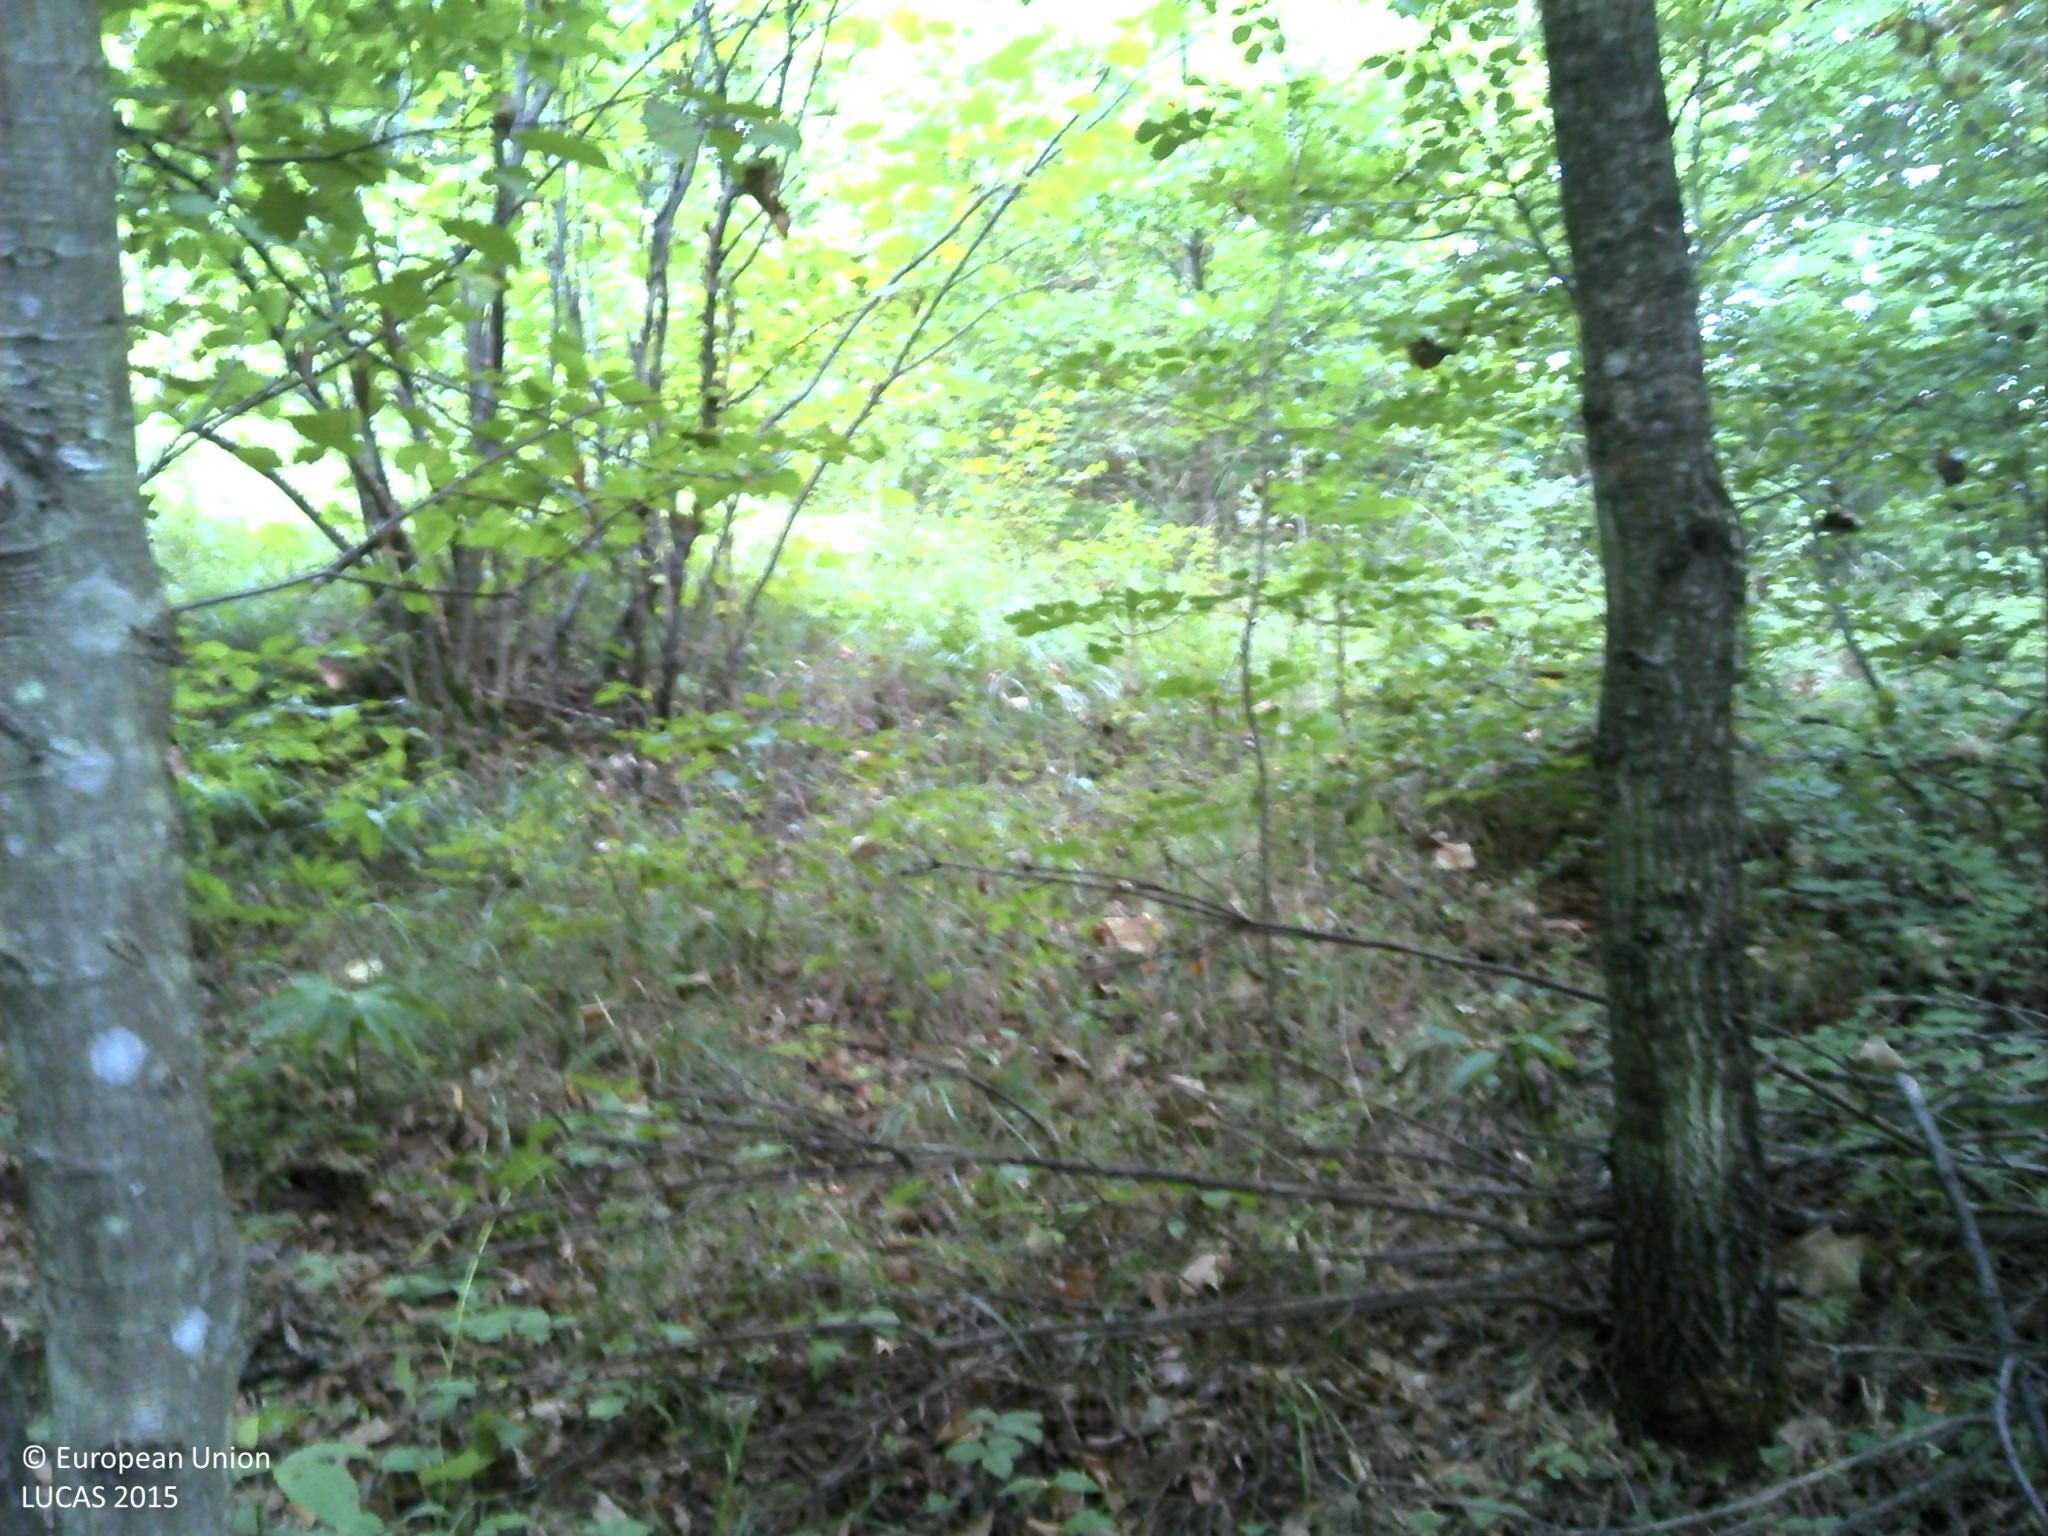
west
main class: Woodland
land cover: Broadleaved woodland
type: beech forest
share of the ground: > 75 %
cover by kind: broadleaved forest trees 100 %
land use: Forestry
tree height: > 5 m
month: September
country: HR
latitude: 45.2868
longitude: 15.1844
